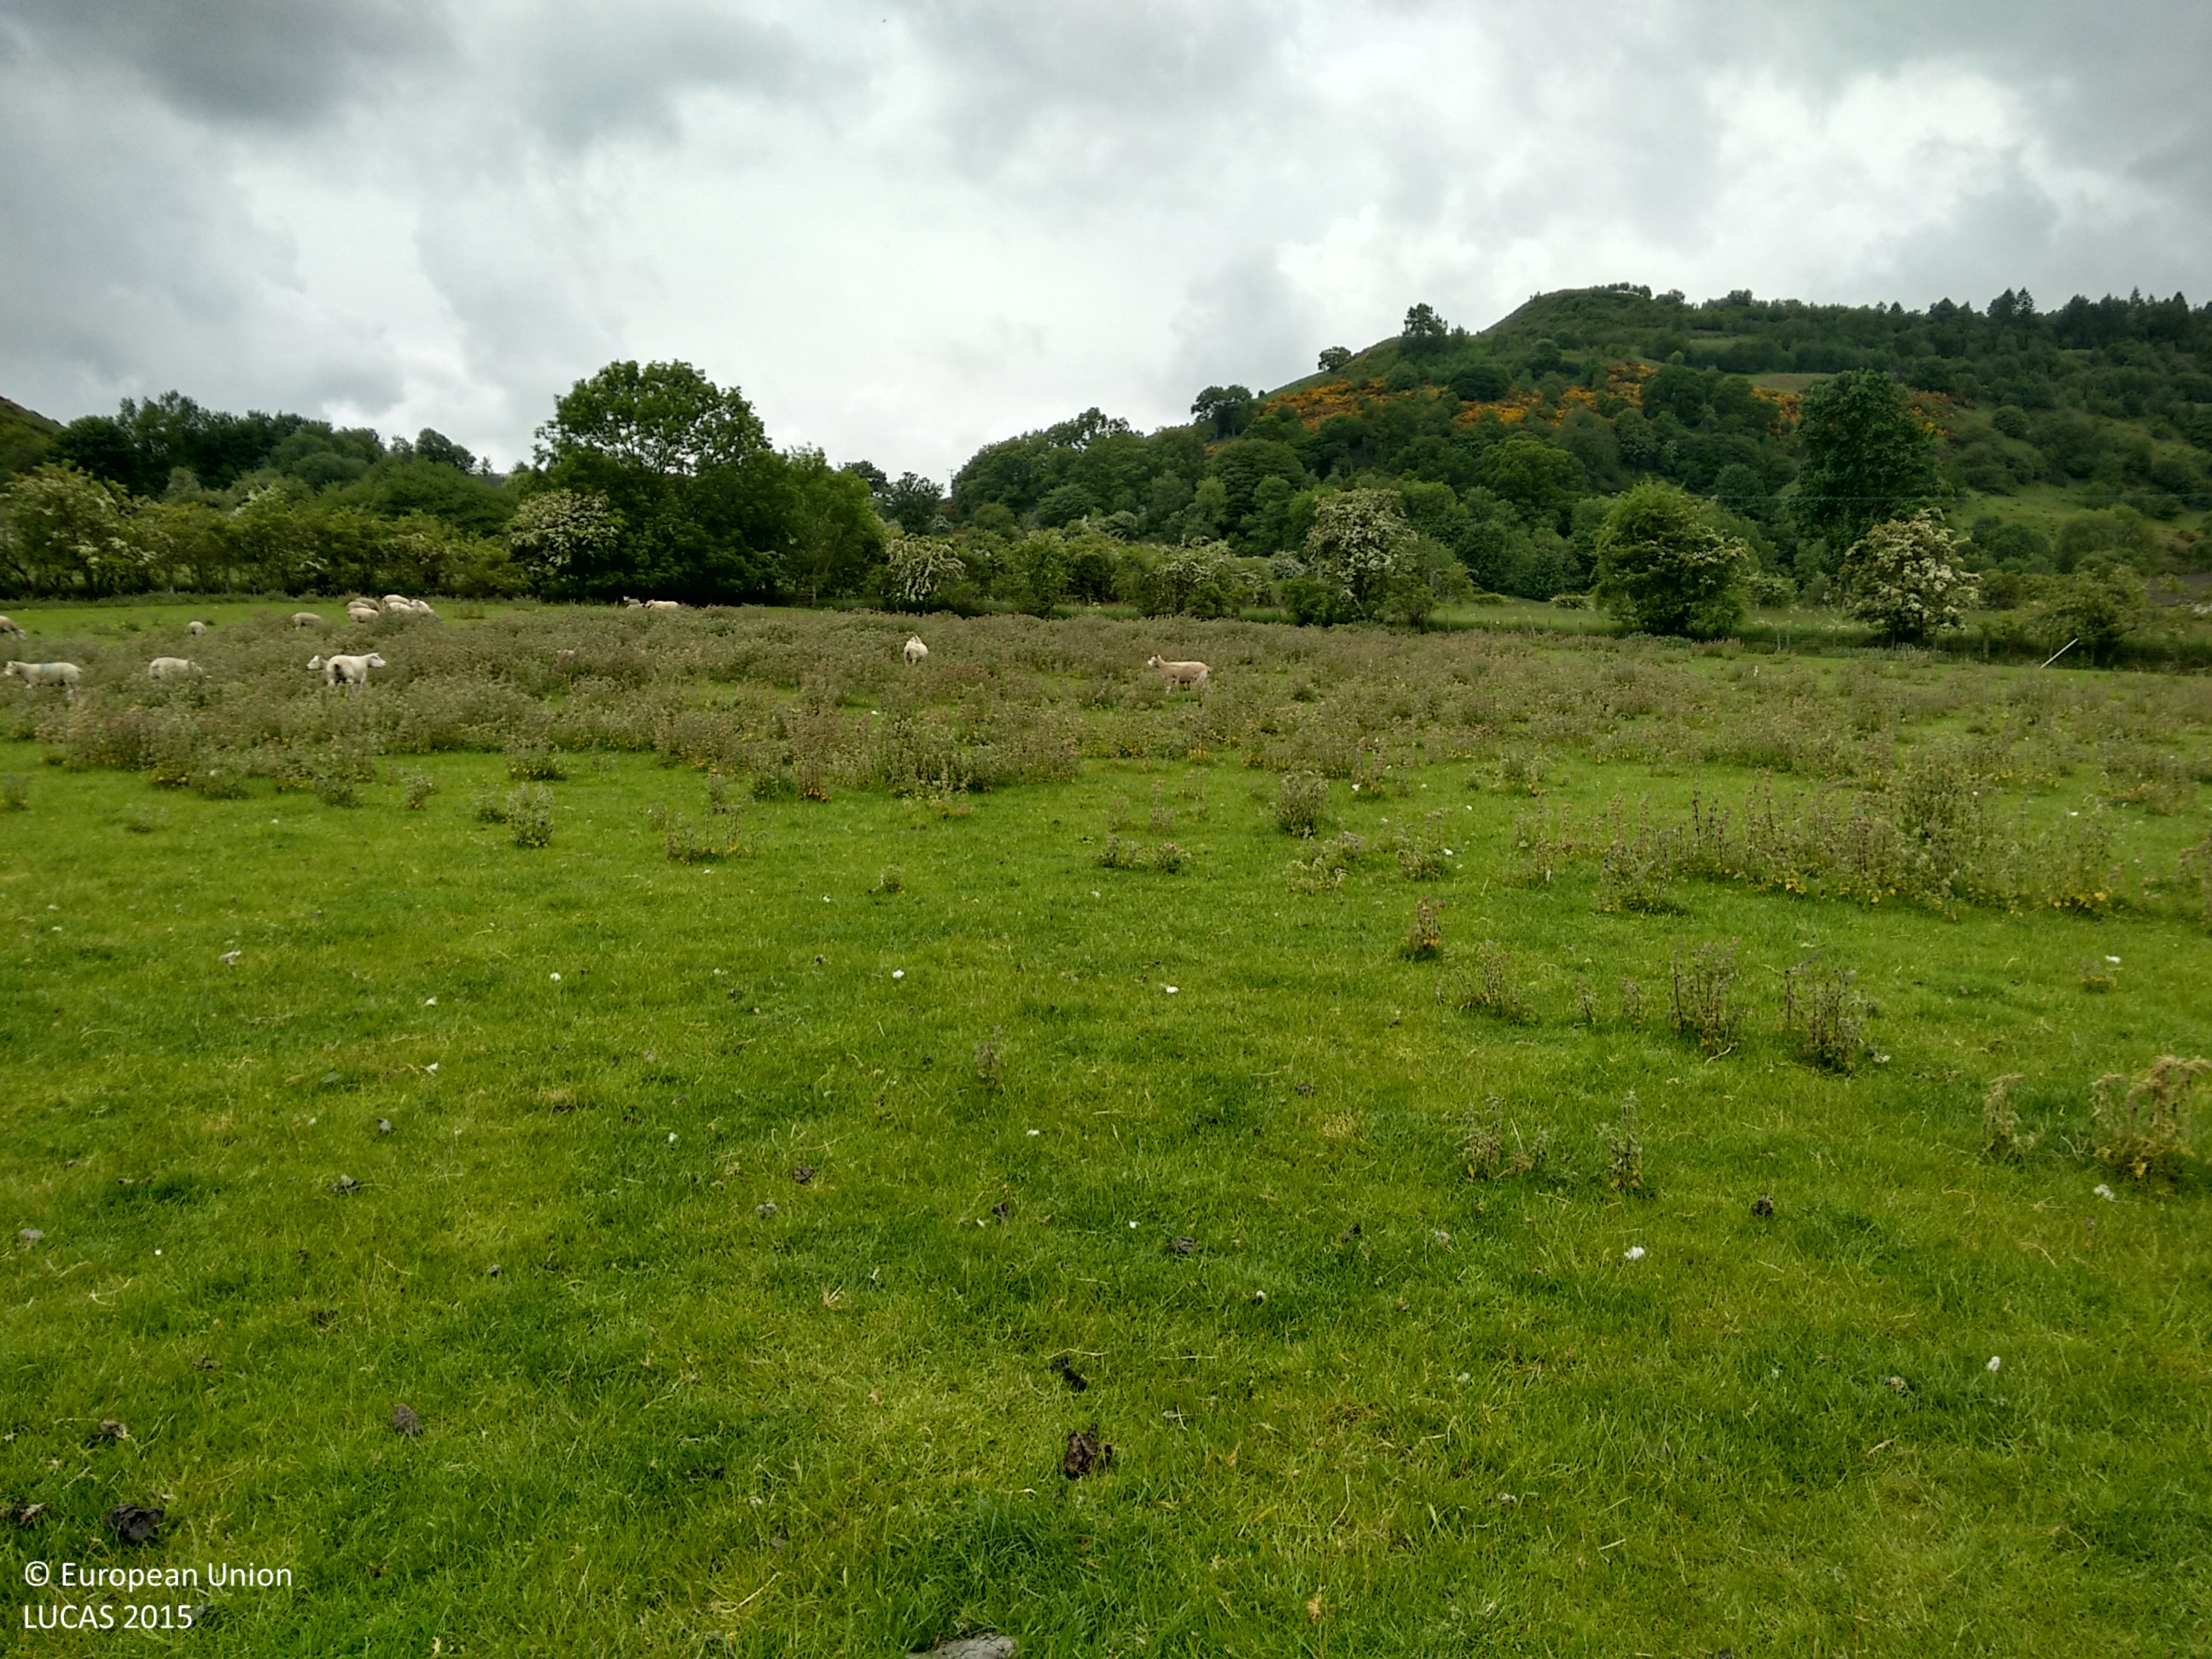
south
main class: Grassland
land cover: Grassland without tree/shrub cover
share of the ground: > 75 %
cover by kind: herbaceous plants 100 %
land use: Agriculture (excluding fallow land and kitchen gardens)
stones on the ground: < 10 %
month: June
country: GB
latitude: 56.3291
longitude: -3.3177
